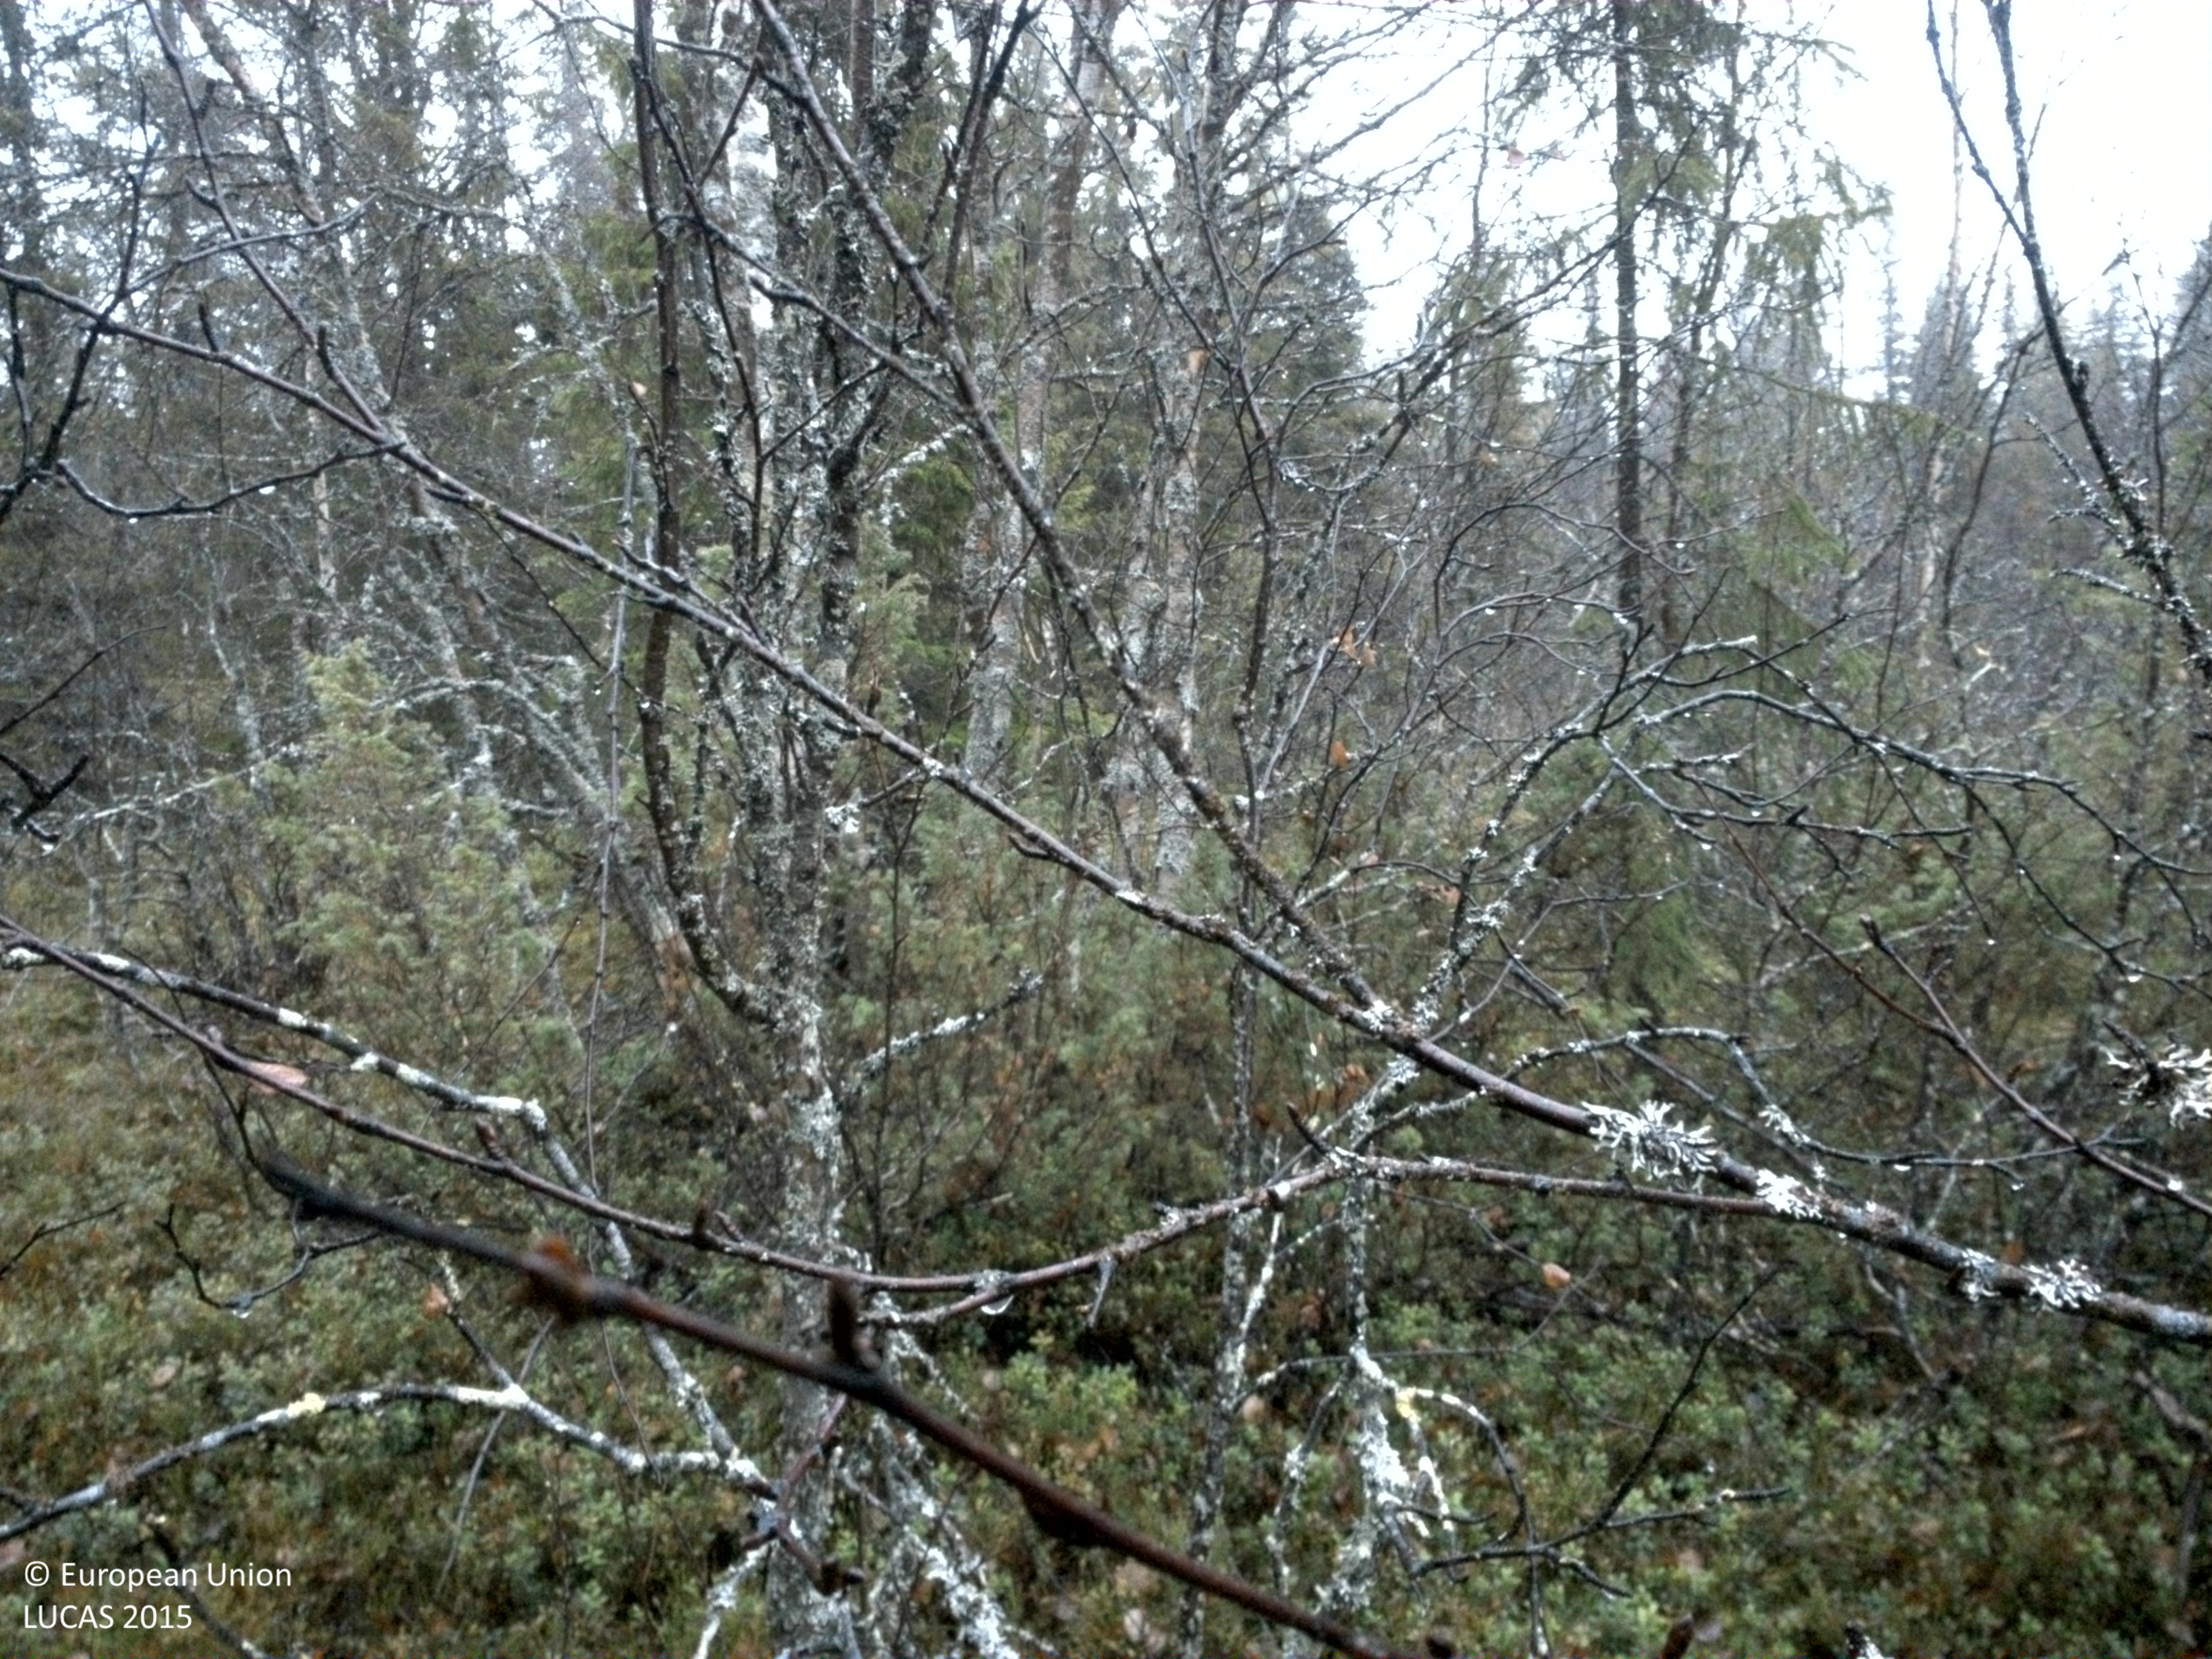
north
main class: Woodland
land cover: Spruce dominated mixed woodland
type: boreal forest
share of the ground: 25 - 50 %
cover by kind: shrubs 40 %, coniferous forest trees 30 %, broadleaved forest trees 15 %, herbaceous plants 10 %, lichens and mosses 5 %
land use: Forestry
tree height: > 5 m
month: October
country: SE
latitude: 64.5118
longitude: 17.4858
